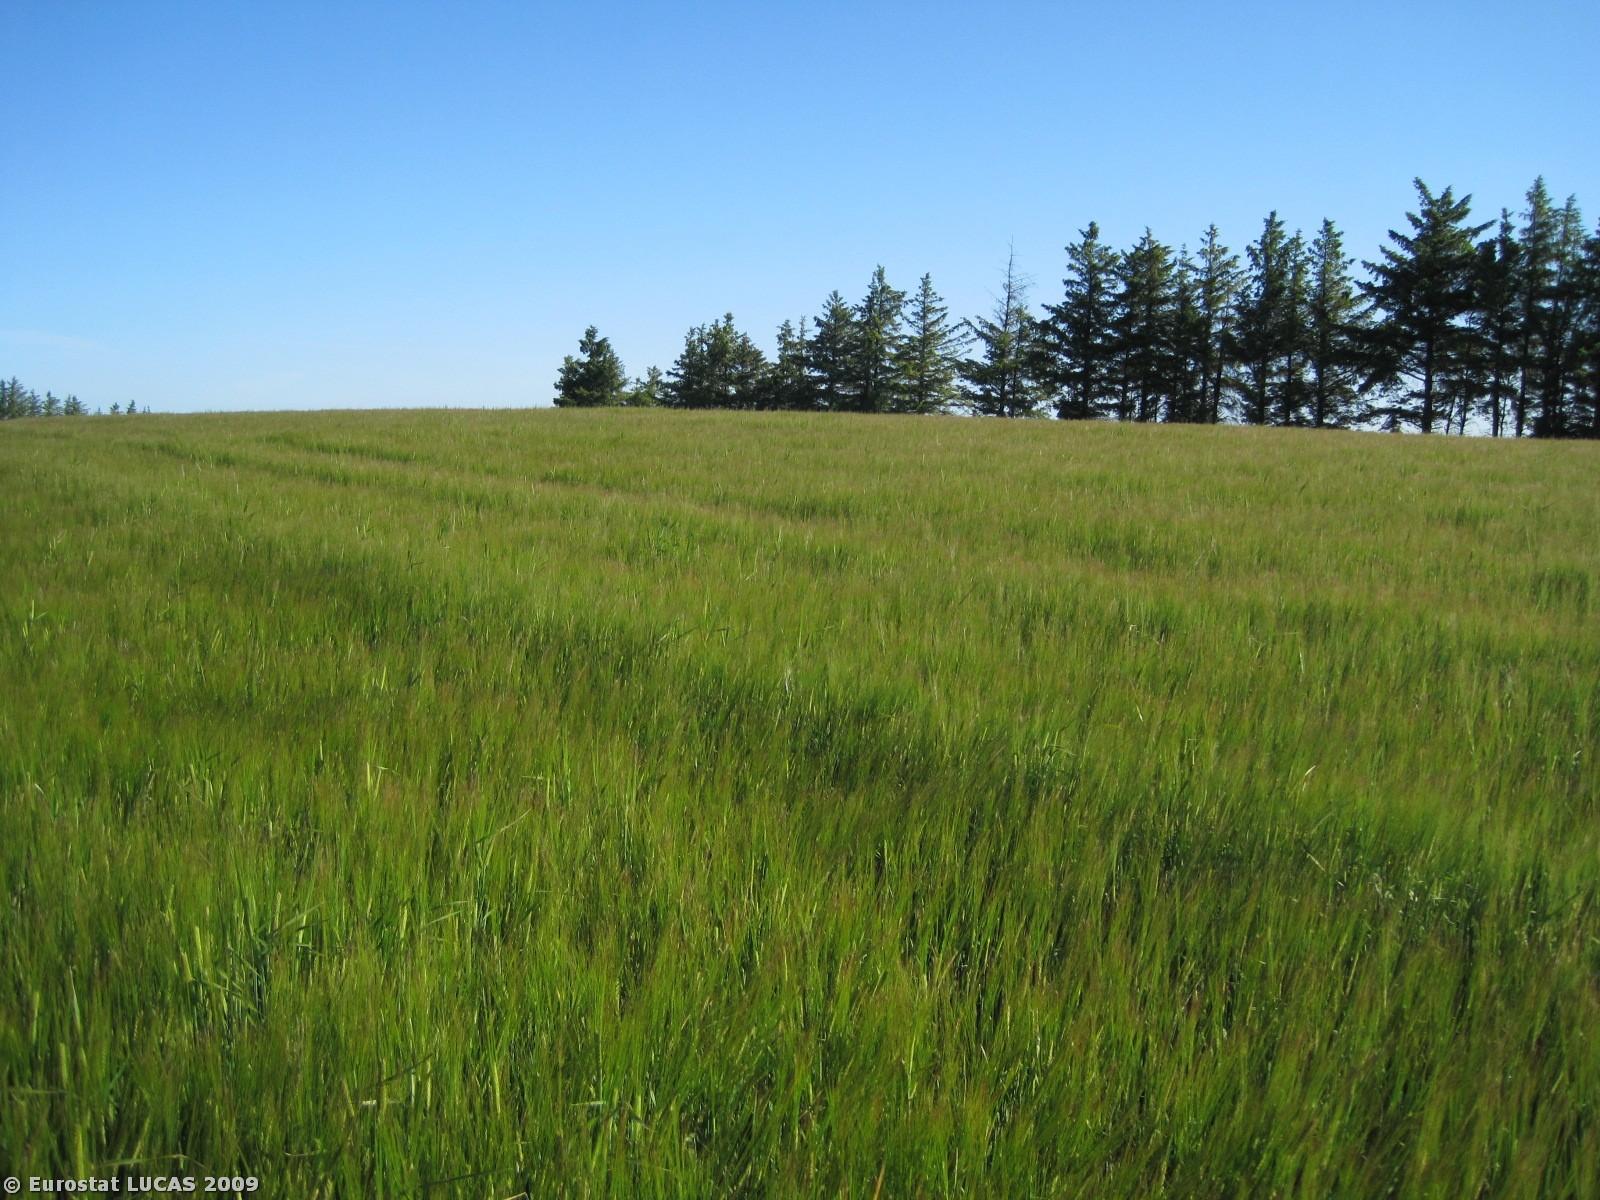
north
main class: Cropland
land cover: Barley
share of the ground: > 75 %
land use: Agriculture (excluding fallow land and kitchen gardens)
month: June
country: DK
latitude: 56.5808
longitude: 9.2033
